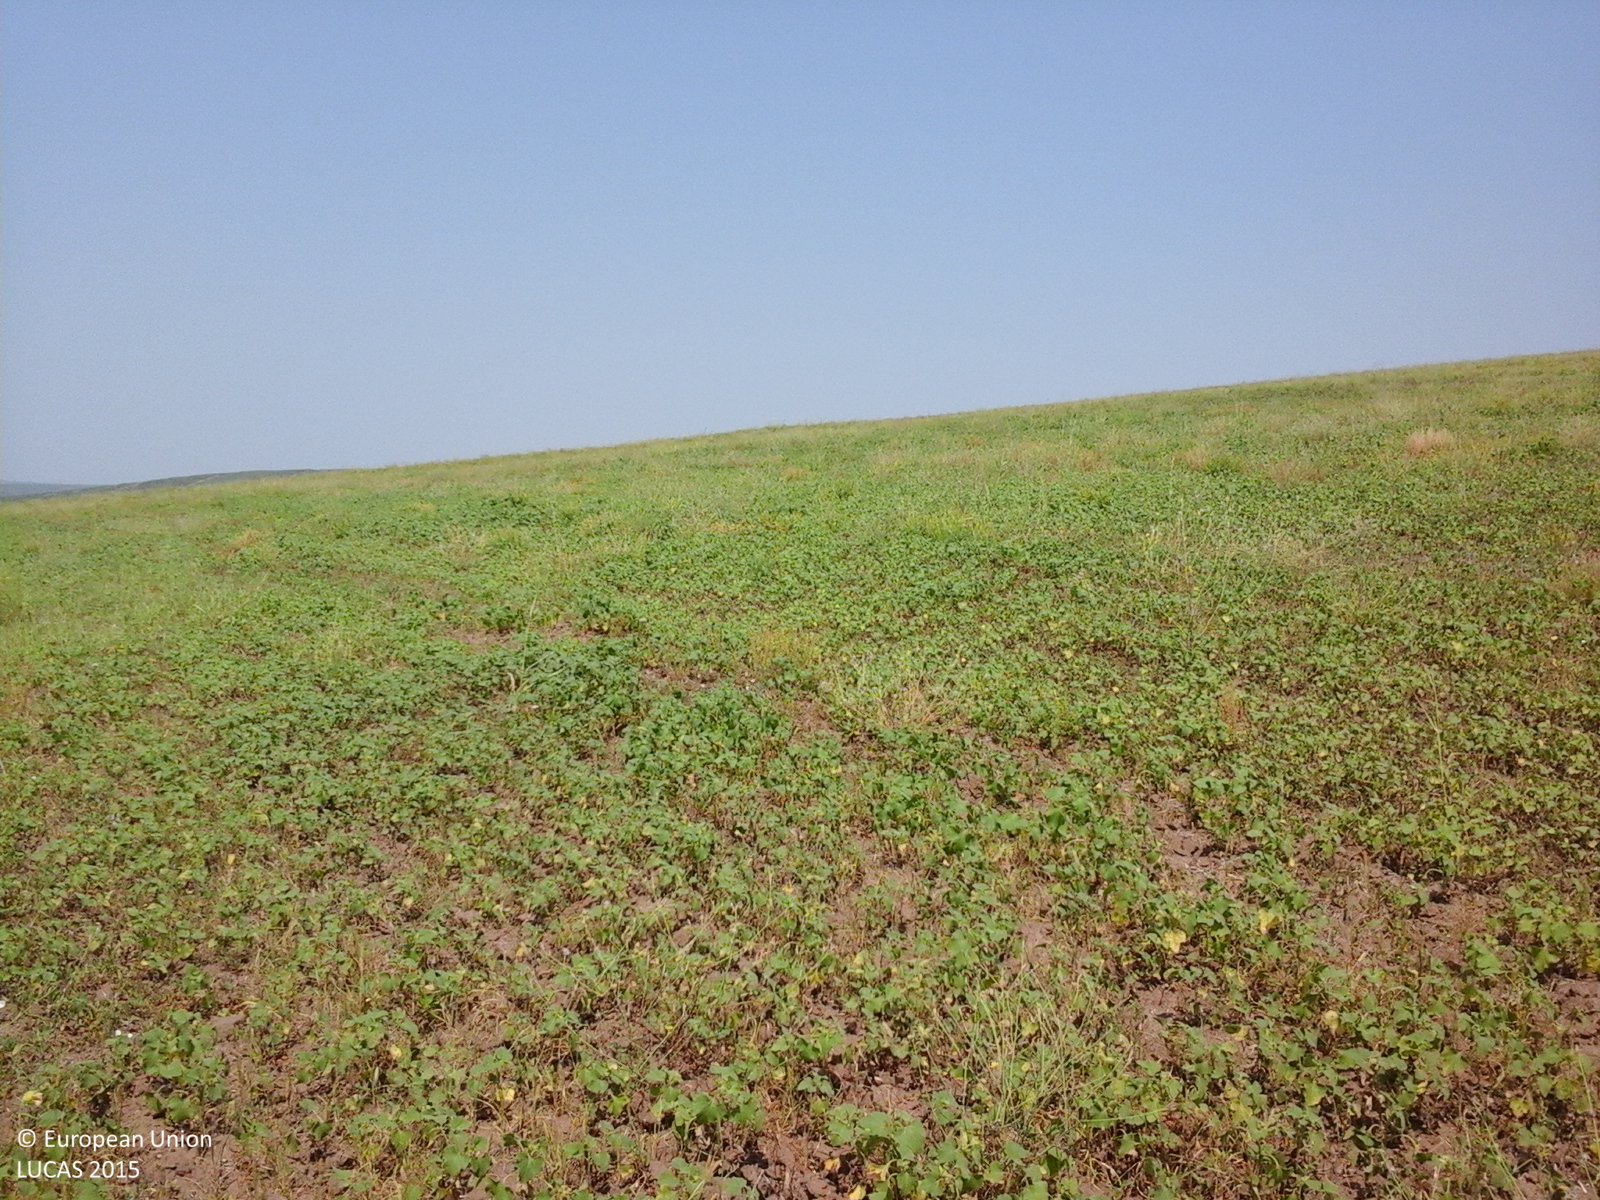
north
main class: Grassland
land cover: Spontaneously vegetated surfaces
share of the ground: > 75 %
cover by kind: herbaceous plants 100 %
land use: Agriculture (excluding fallow land and kitchen gardens)
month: July
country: RO
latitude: 45.8090
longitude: 27.9677
